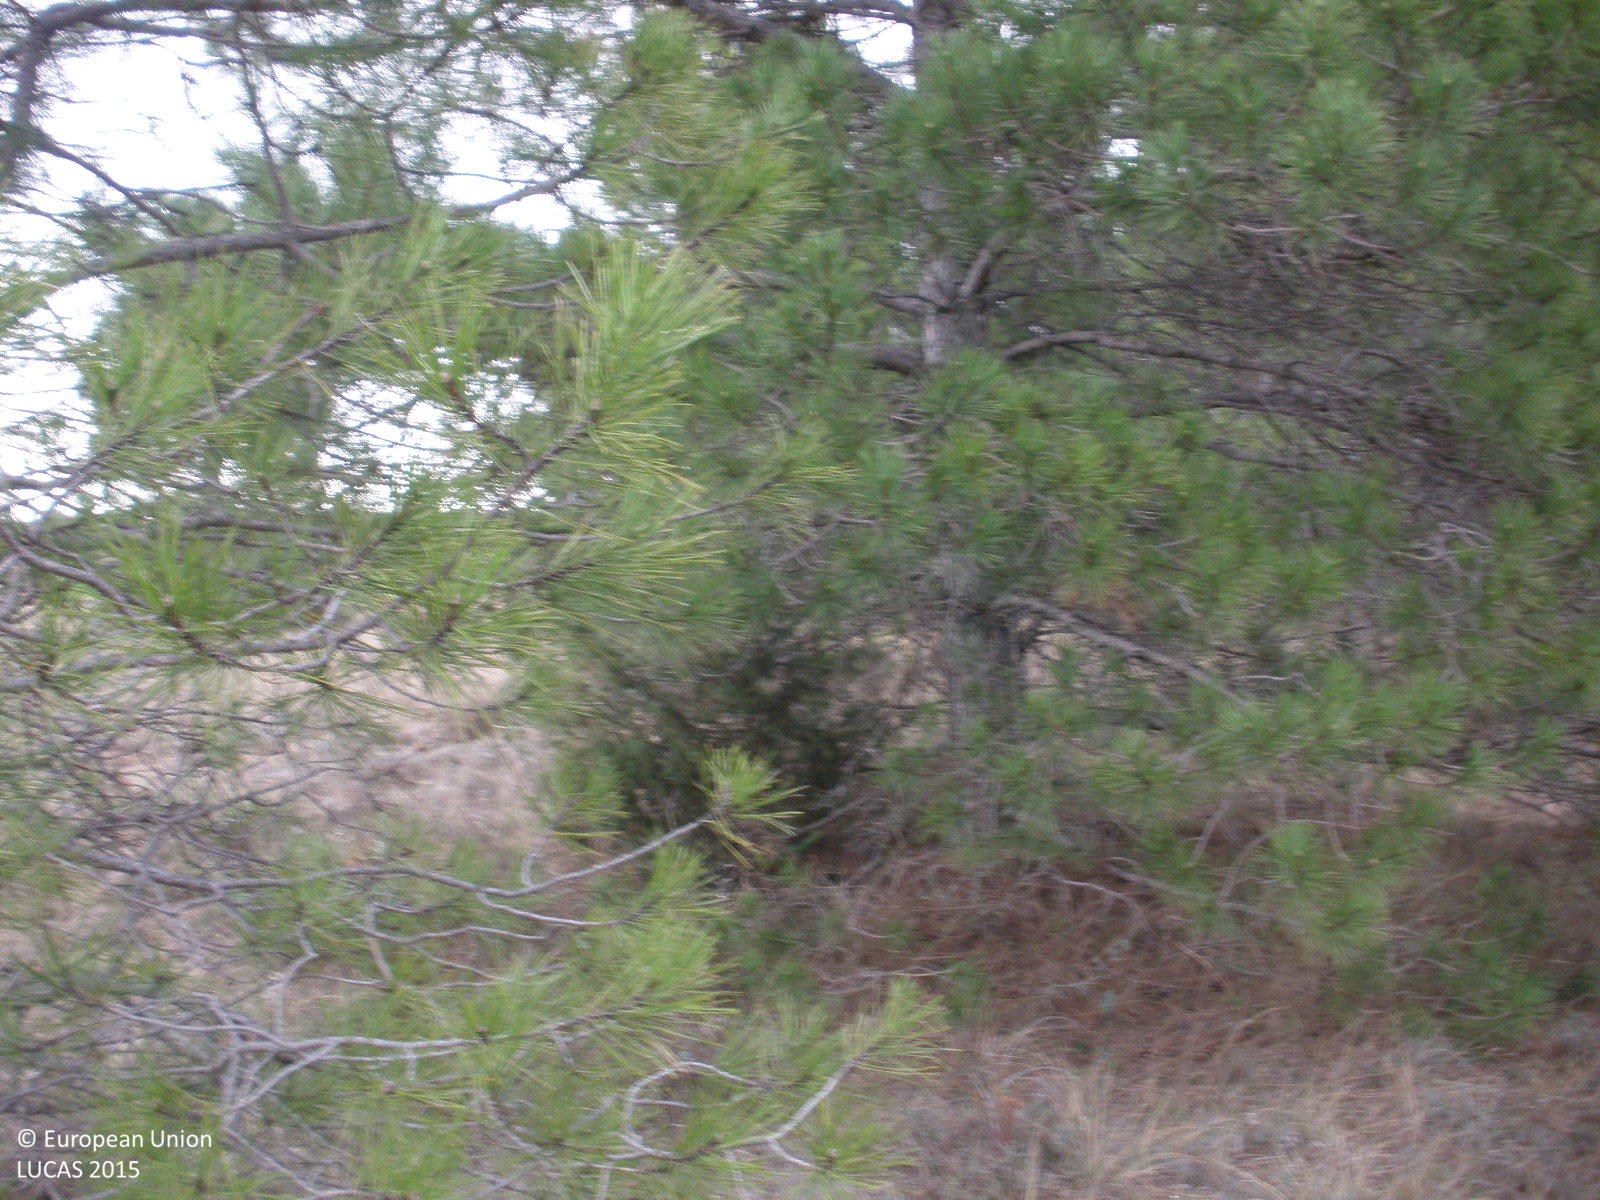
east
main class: Woodland
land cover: Pine dominated coniferous woodland
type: coniferous forest of the mediterranean region
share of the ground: 50 - 75 %
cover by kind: coniferous forest trees 60 %, shrubs 30 %, herbaceous plants 10 %
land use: Semi-natural and natural areas not in use
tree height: > 5 m
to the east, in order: Pine dominated coniferous woodland; Barley; Shrubland without tree cover; Tracks; Other bare soil; Shrubland without tree cover; Tracks; Shrubland without tree cover; Spontaneously vegetated surfaces
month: April
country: ES
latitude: 40.7825
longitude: -1.1183
